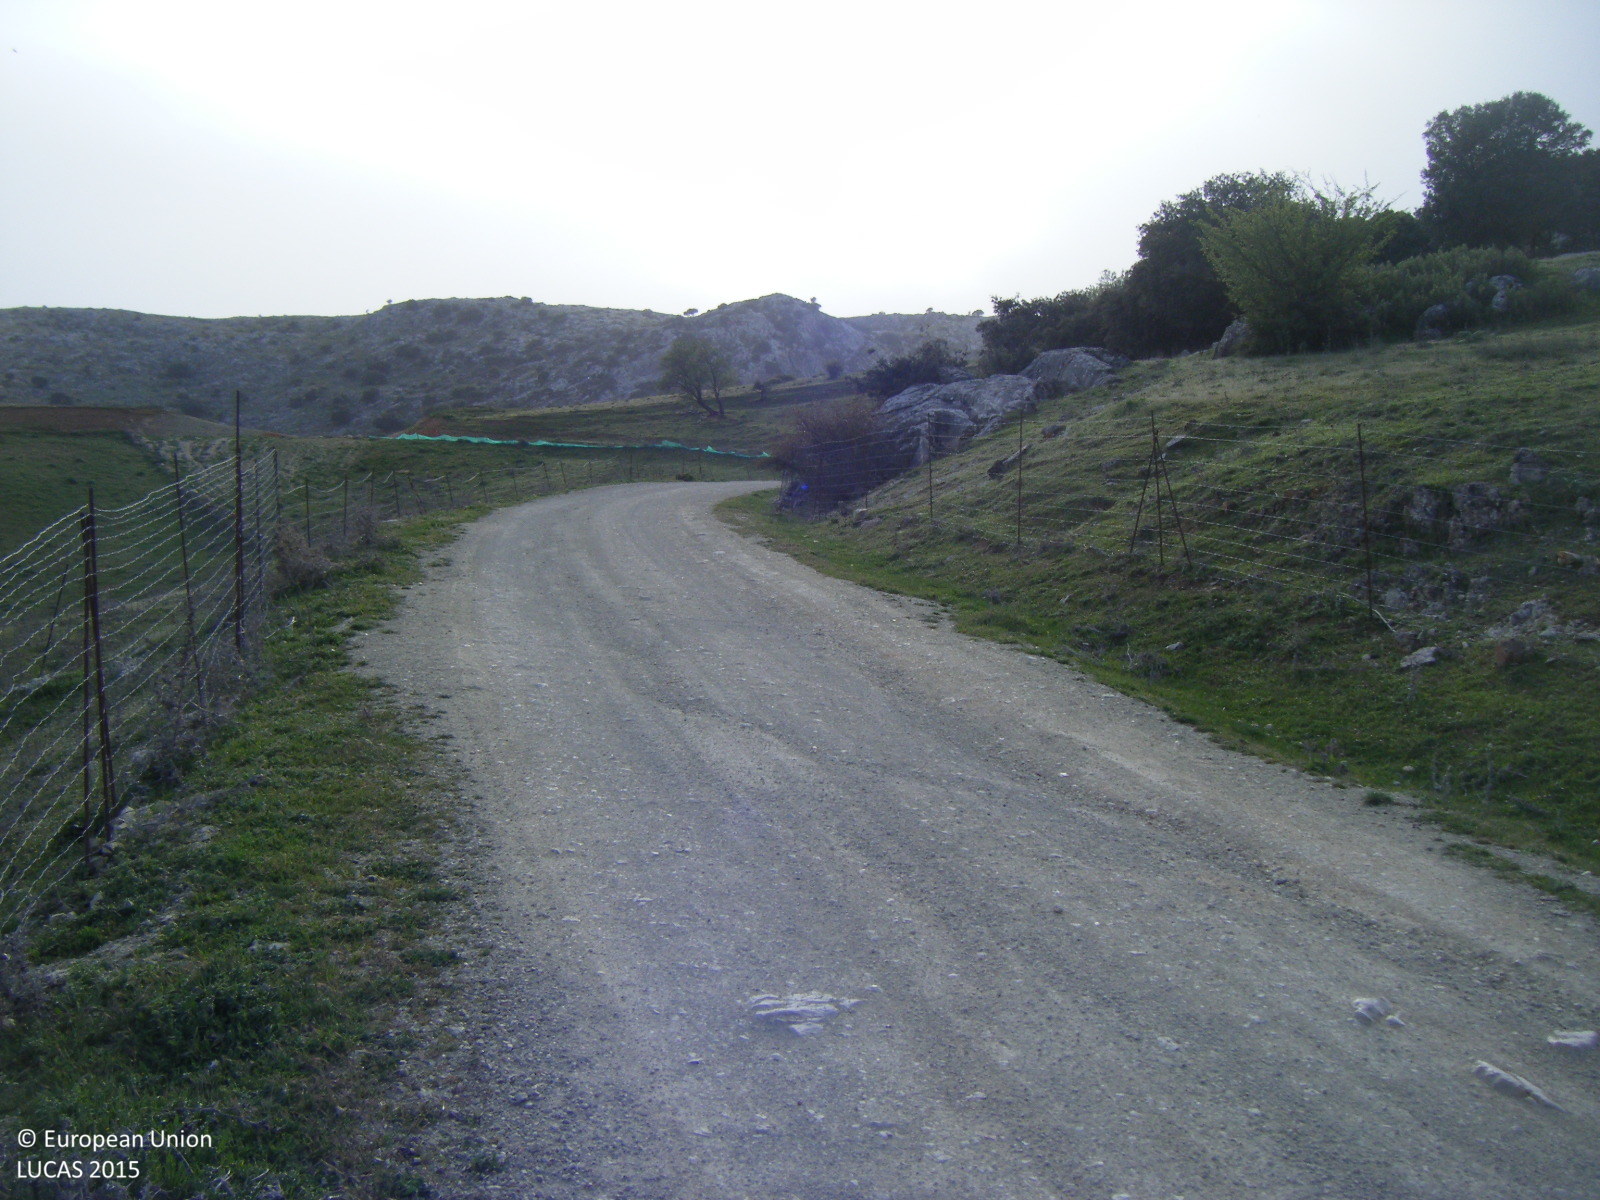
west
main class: Grassland
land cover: Grassland without tree/shrub cover
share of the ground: > 75 %
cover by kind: herbaceous plants 100 %
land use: Agriculture (excluding fallow land and kitchen gardens)
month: April
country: ES
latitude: 37.0157
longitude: -4.1423
